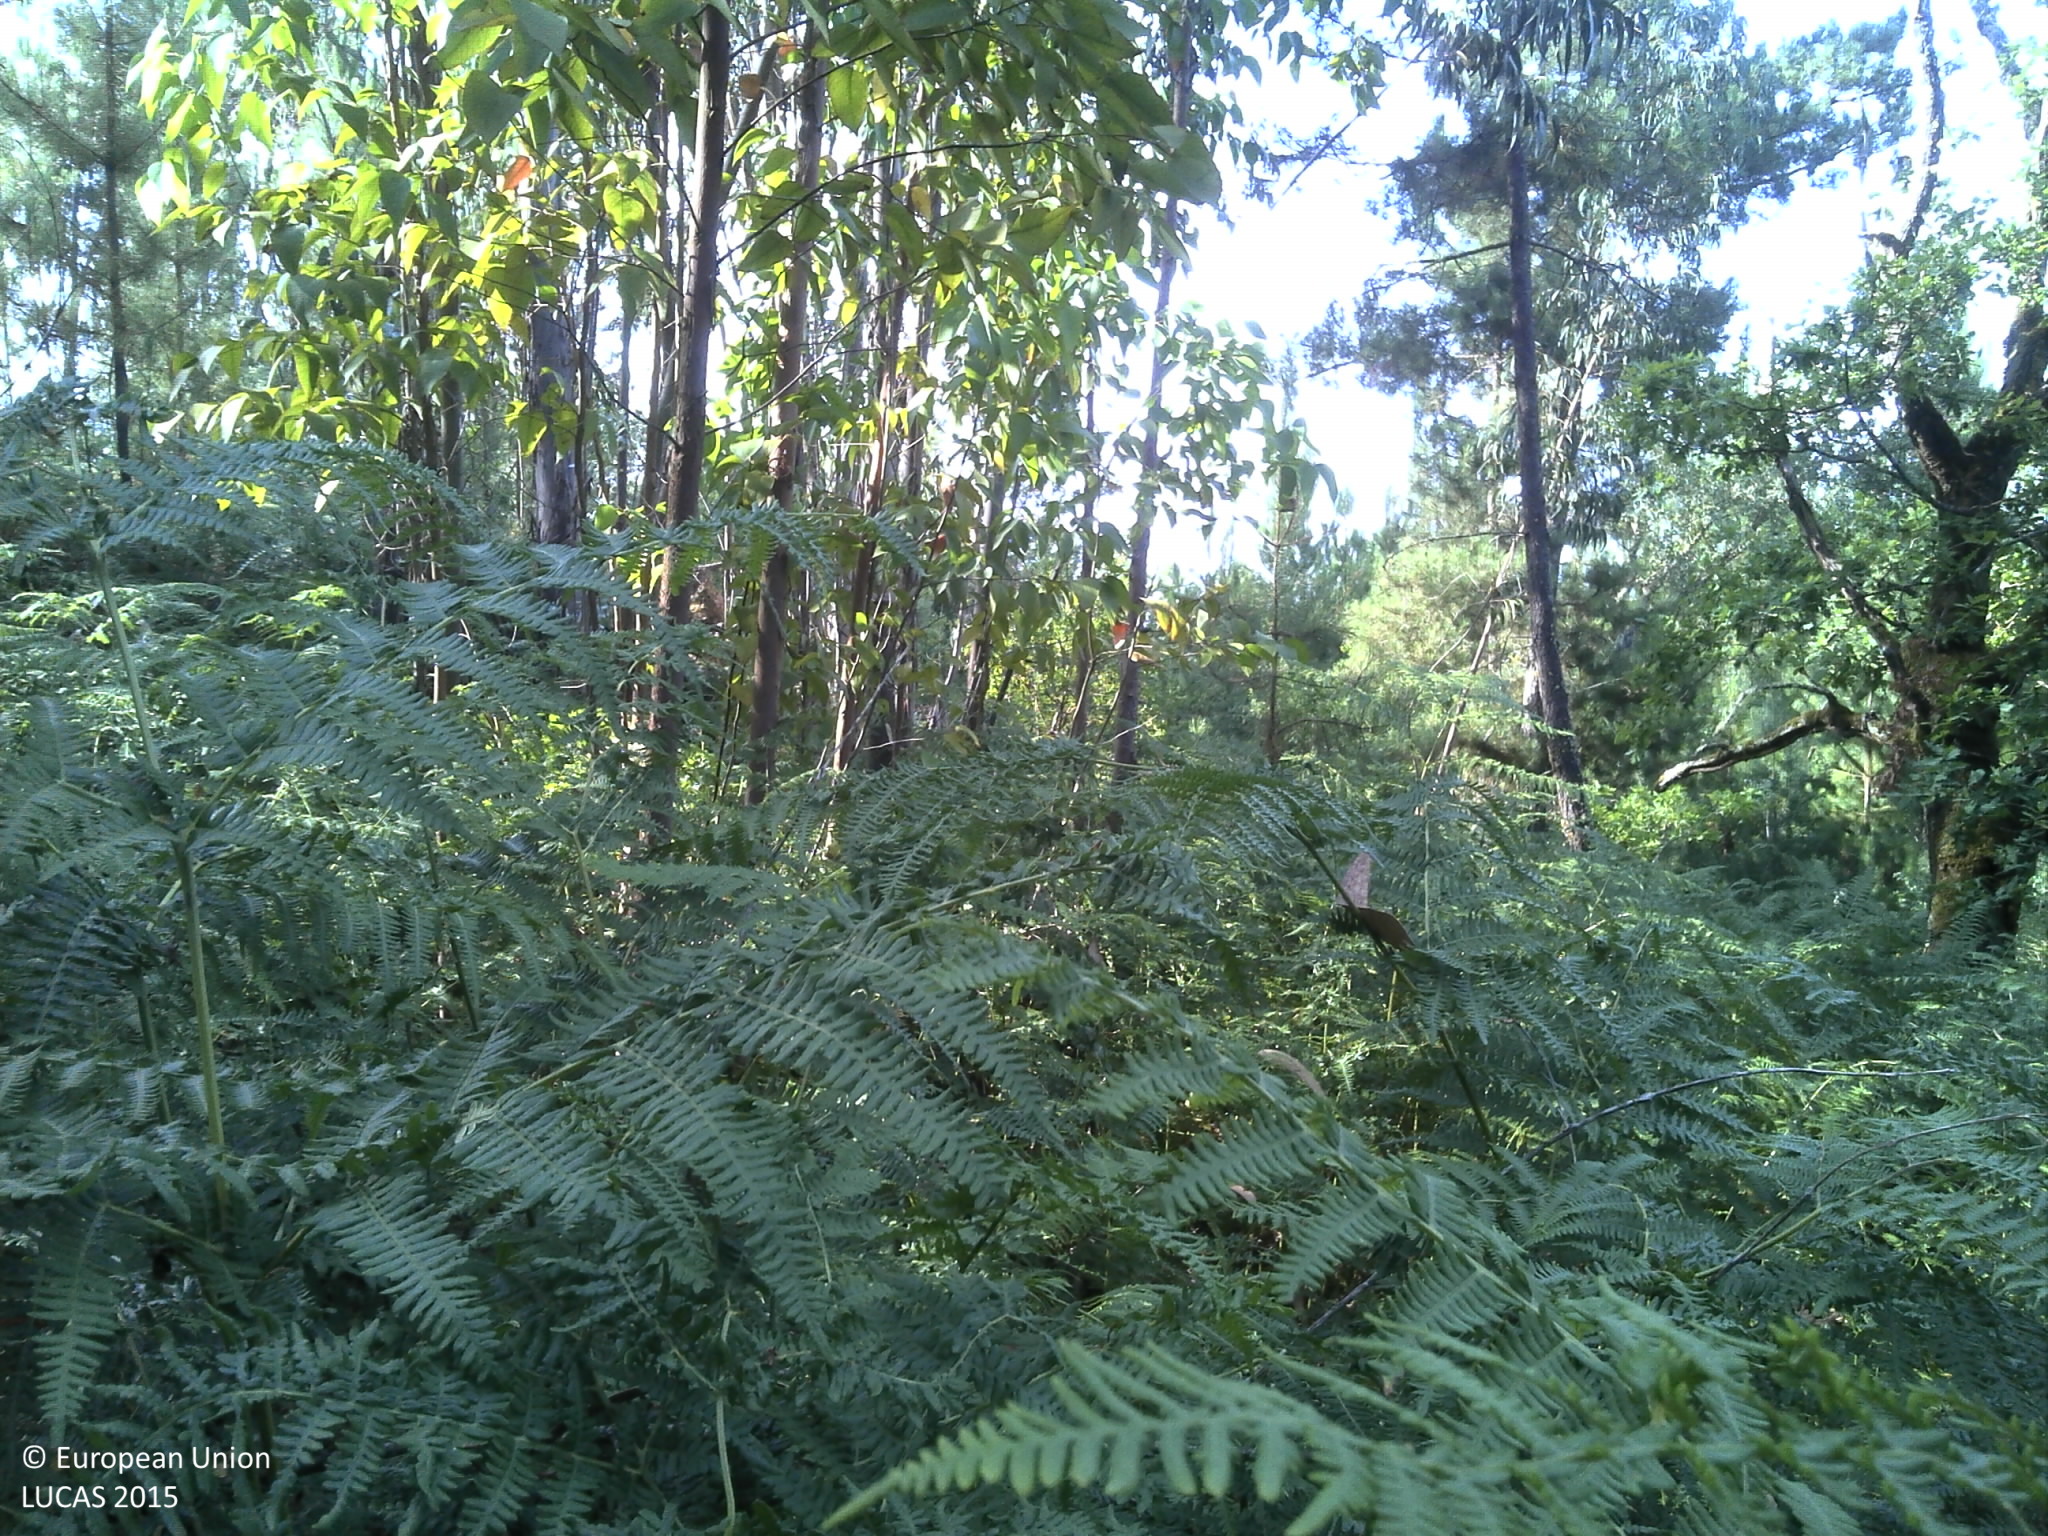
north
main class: Woodland
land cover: Broadleaved woodland
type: exotic forest
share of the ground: 50 - 75 %
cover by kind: broadleaved forest trees 75 %, shrubs 20 %, unconsolidated bare surface 5 %
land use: Forestry
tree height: > 5 m
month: July
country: PT
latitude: 40.2767
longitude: -8.1536
